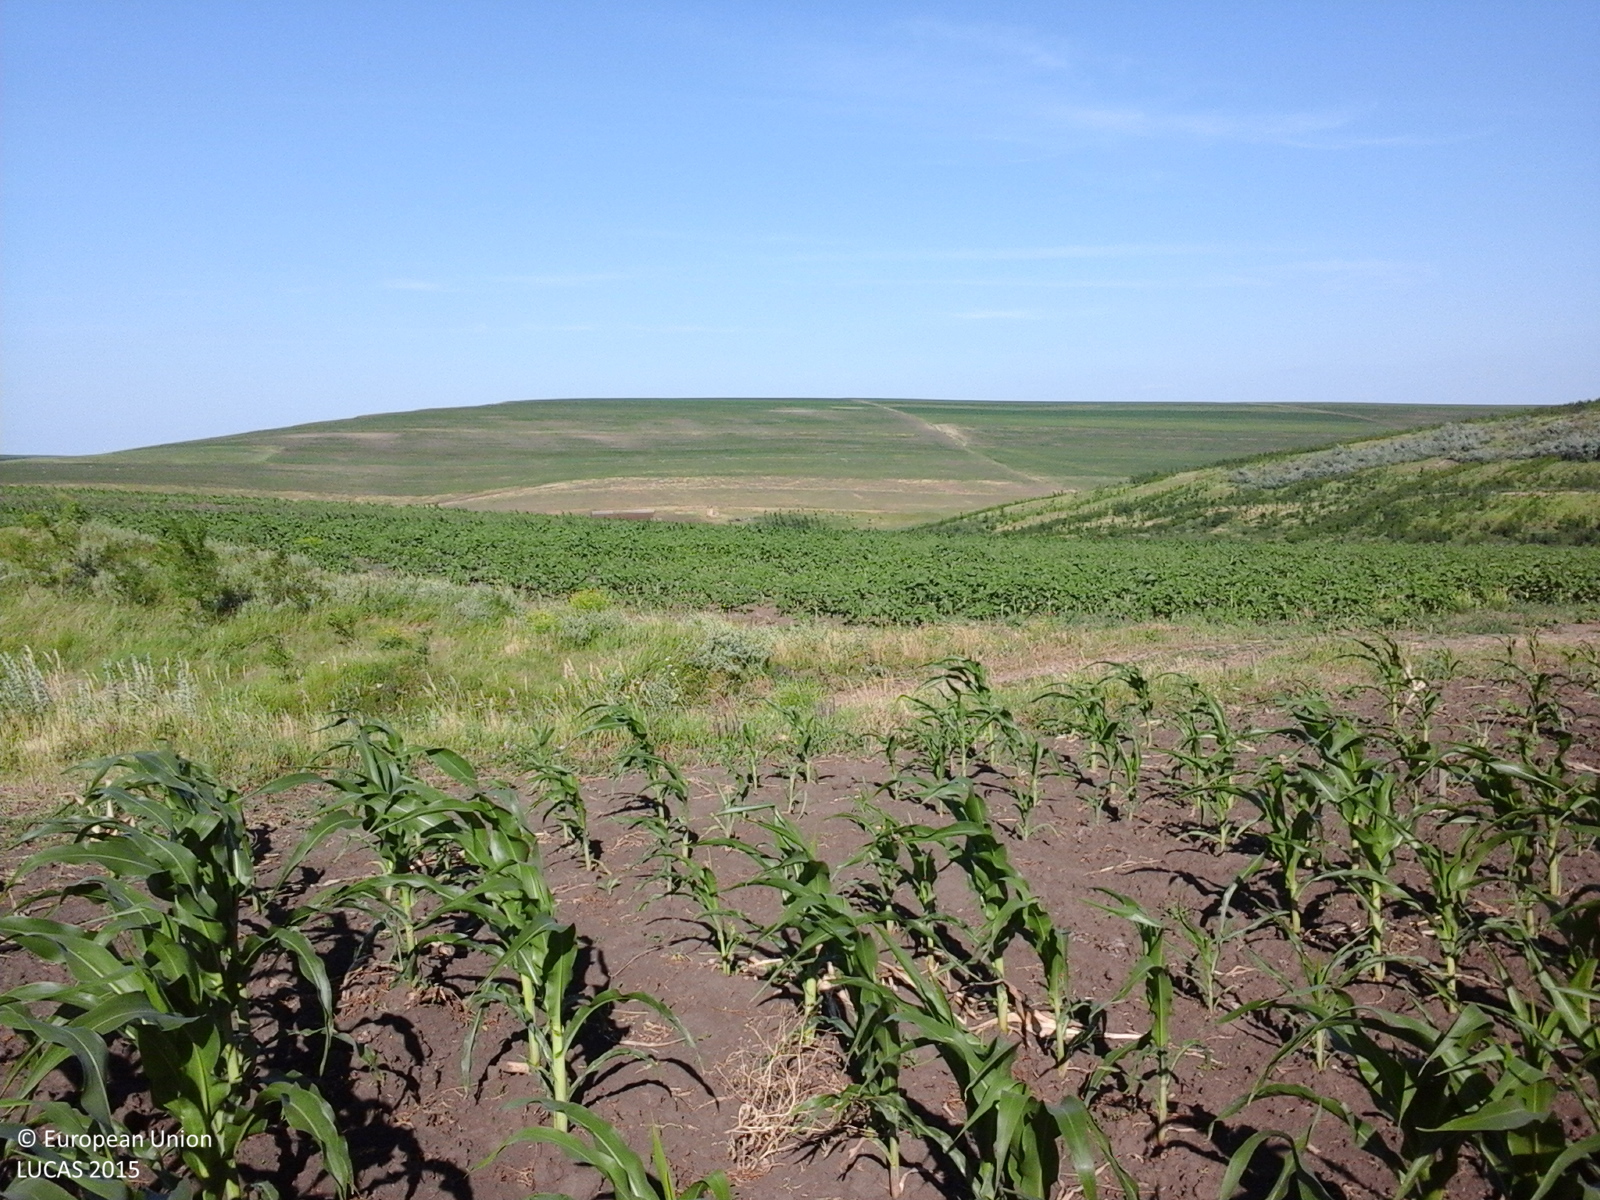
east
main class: Cropland
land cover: Maize
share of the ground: 50 - 75 %
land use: Agriculture (excluding fallow land and kitchen gardens)
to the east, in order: Maize; Grassland without tree/shrub cover; Tracks; Grassland without tree/shrub cover; Sunflower; Maize; Soya; Lucerne; Maize
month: June
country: RO
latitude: 47.4760
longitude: 27.1312
